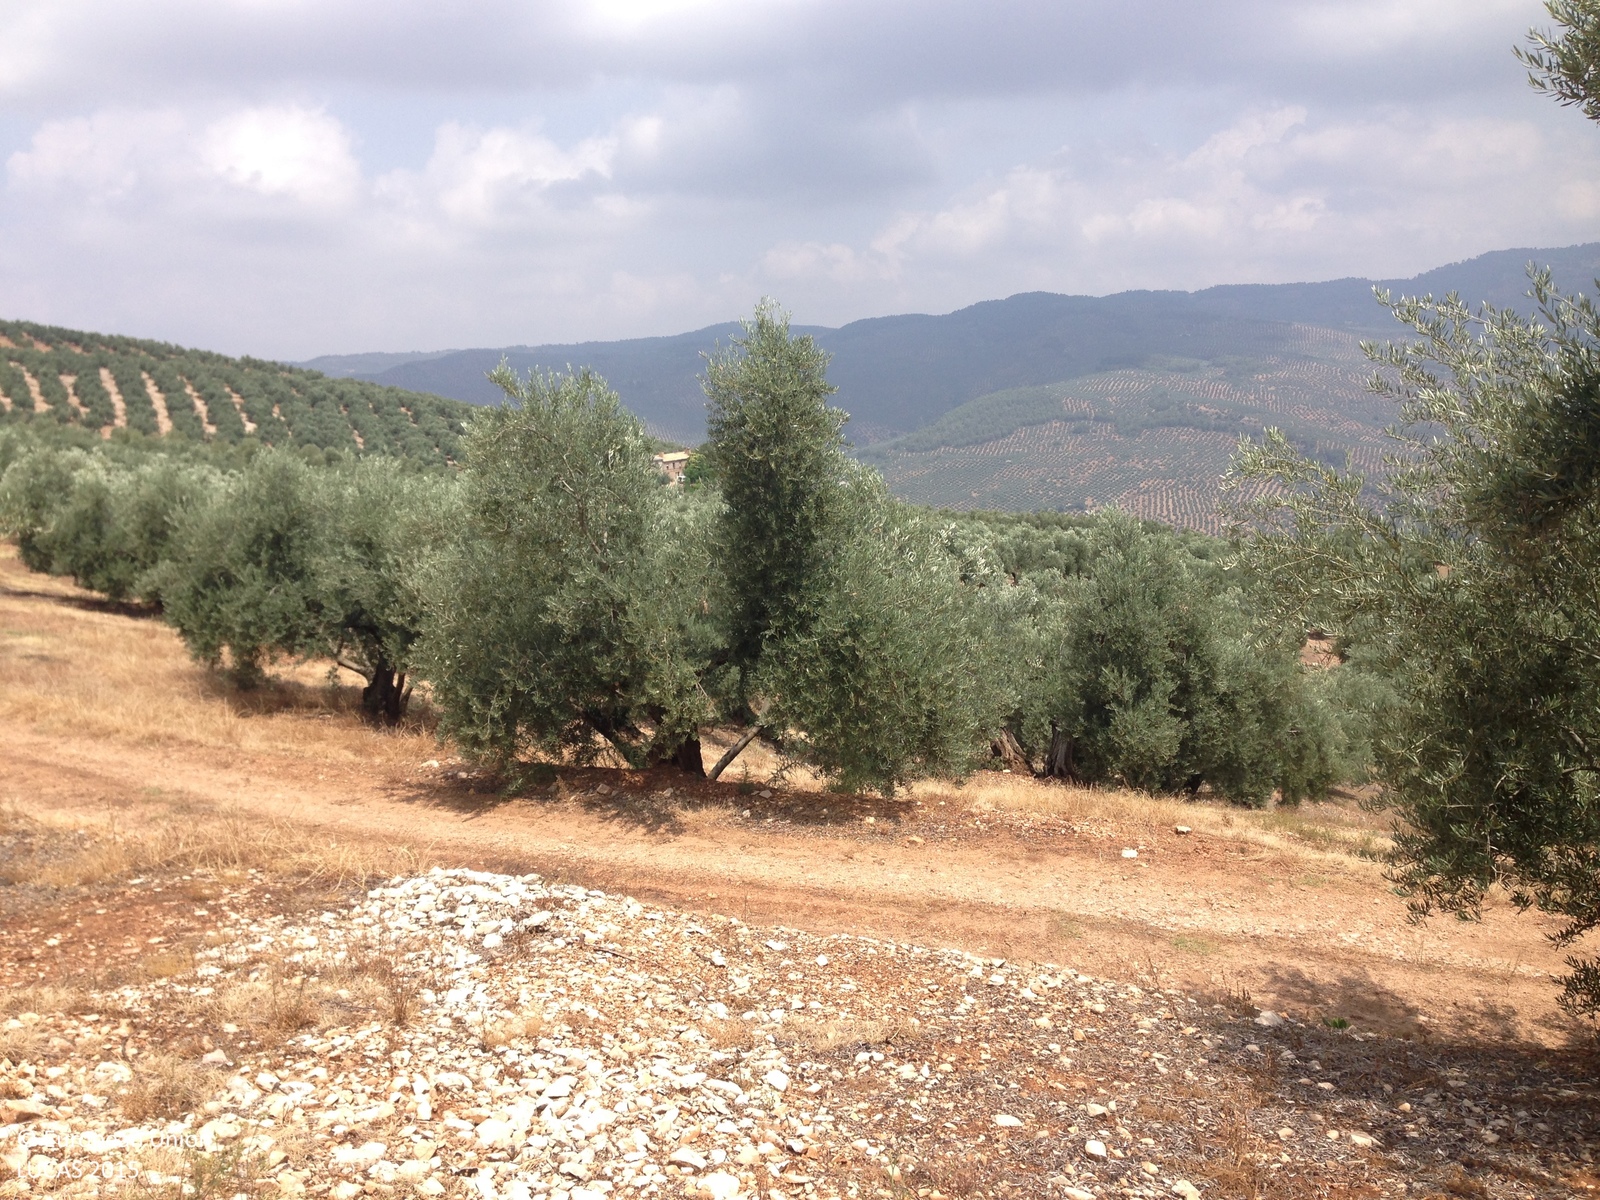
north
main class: Cropland
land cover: Olive groves
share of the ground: 25 - 50 %
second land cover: Other bare soil
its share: > 75 %
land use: Agriculture (excluding fallow land and kitchen gardens)
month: June
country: ES
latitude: 38.1657
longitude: -2.9068
